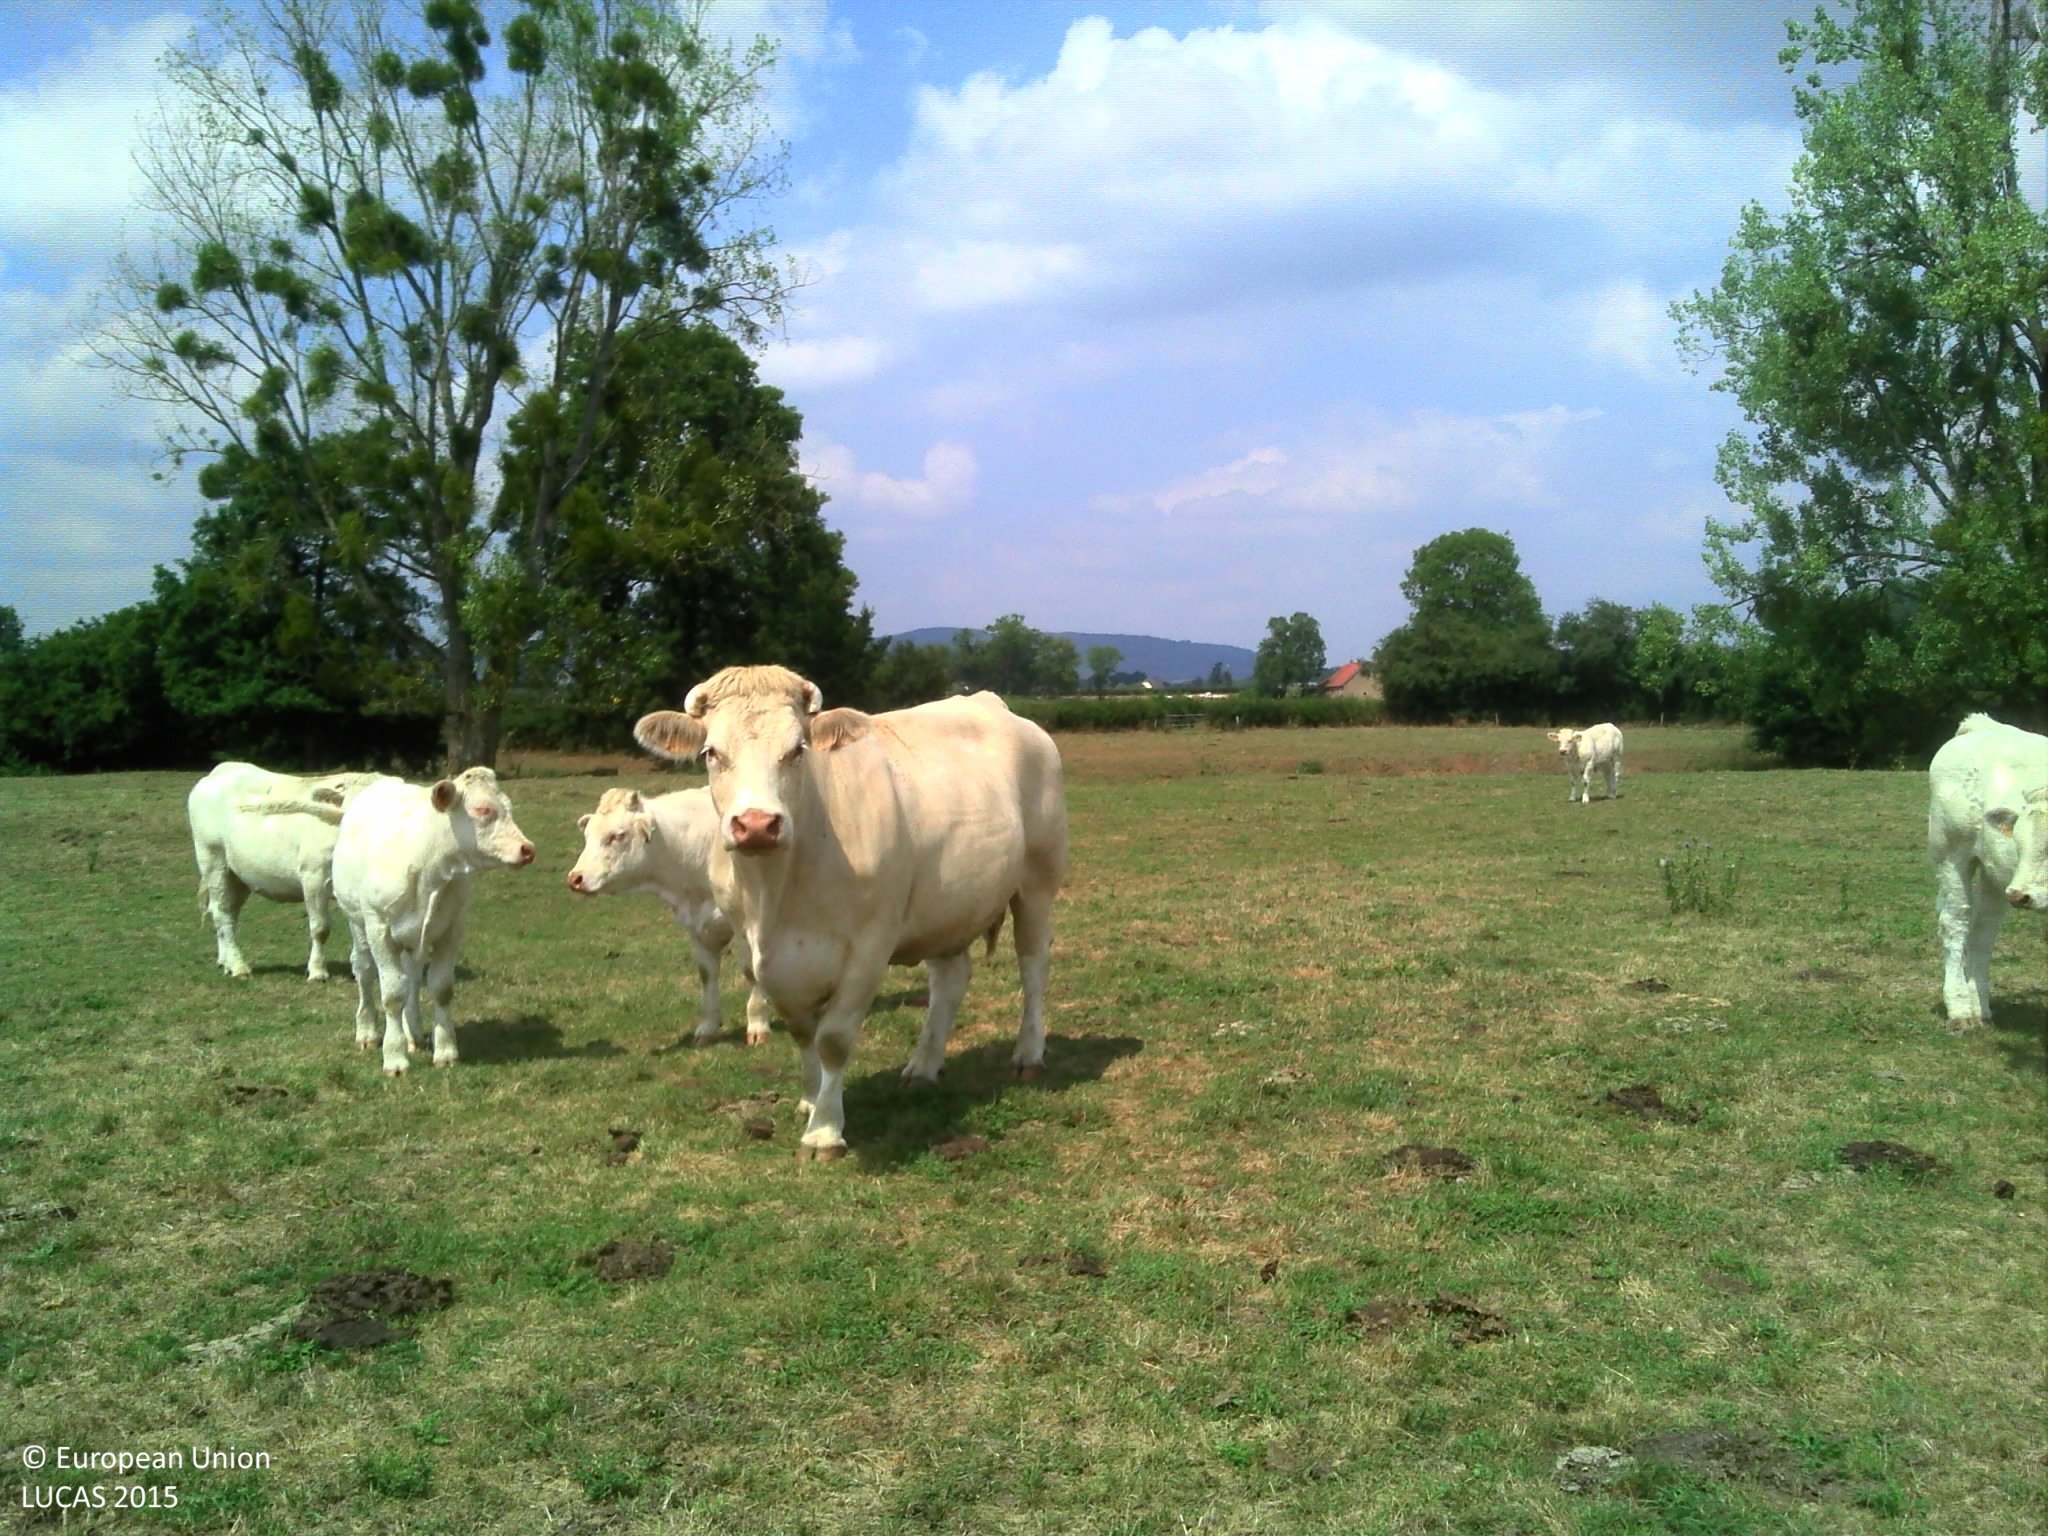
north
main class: Grassland
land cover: Grassland without tree/shrub cover
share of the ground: > 75 %
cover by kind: herbaceous plants 100 %
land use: Agriculture (excluding fallow land and kitchen gardens)
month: August
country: FR
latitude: 47.0131
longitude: 4.3302
